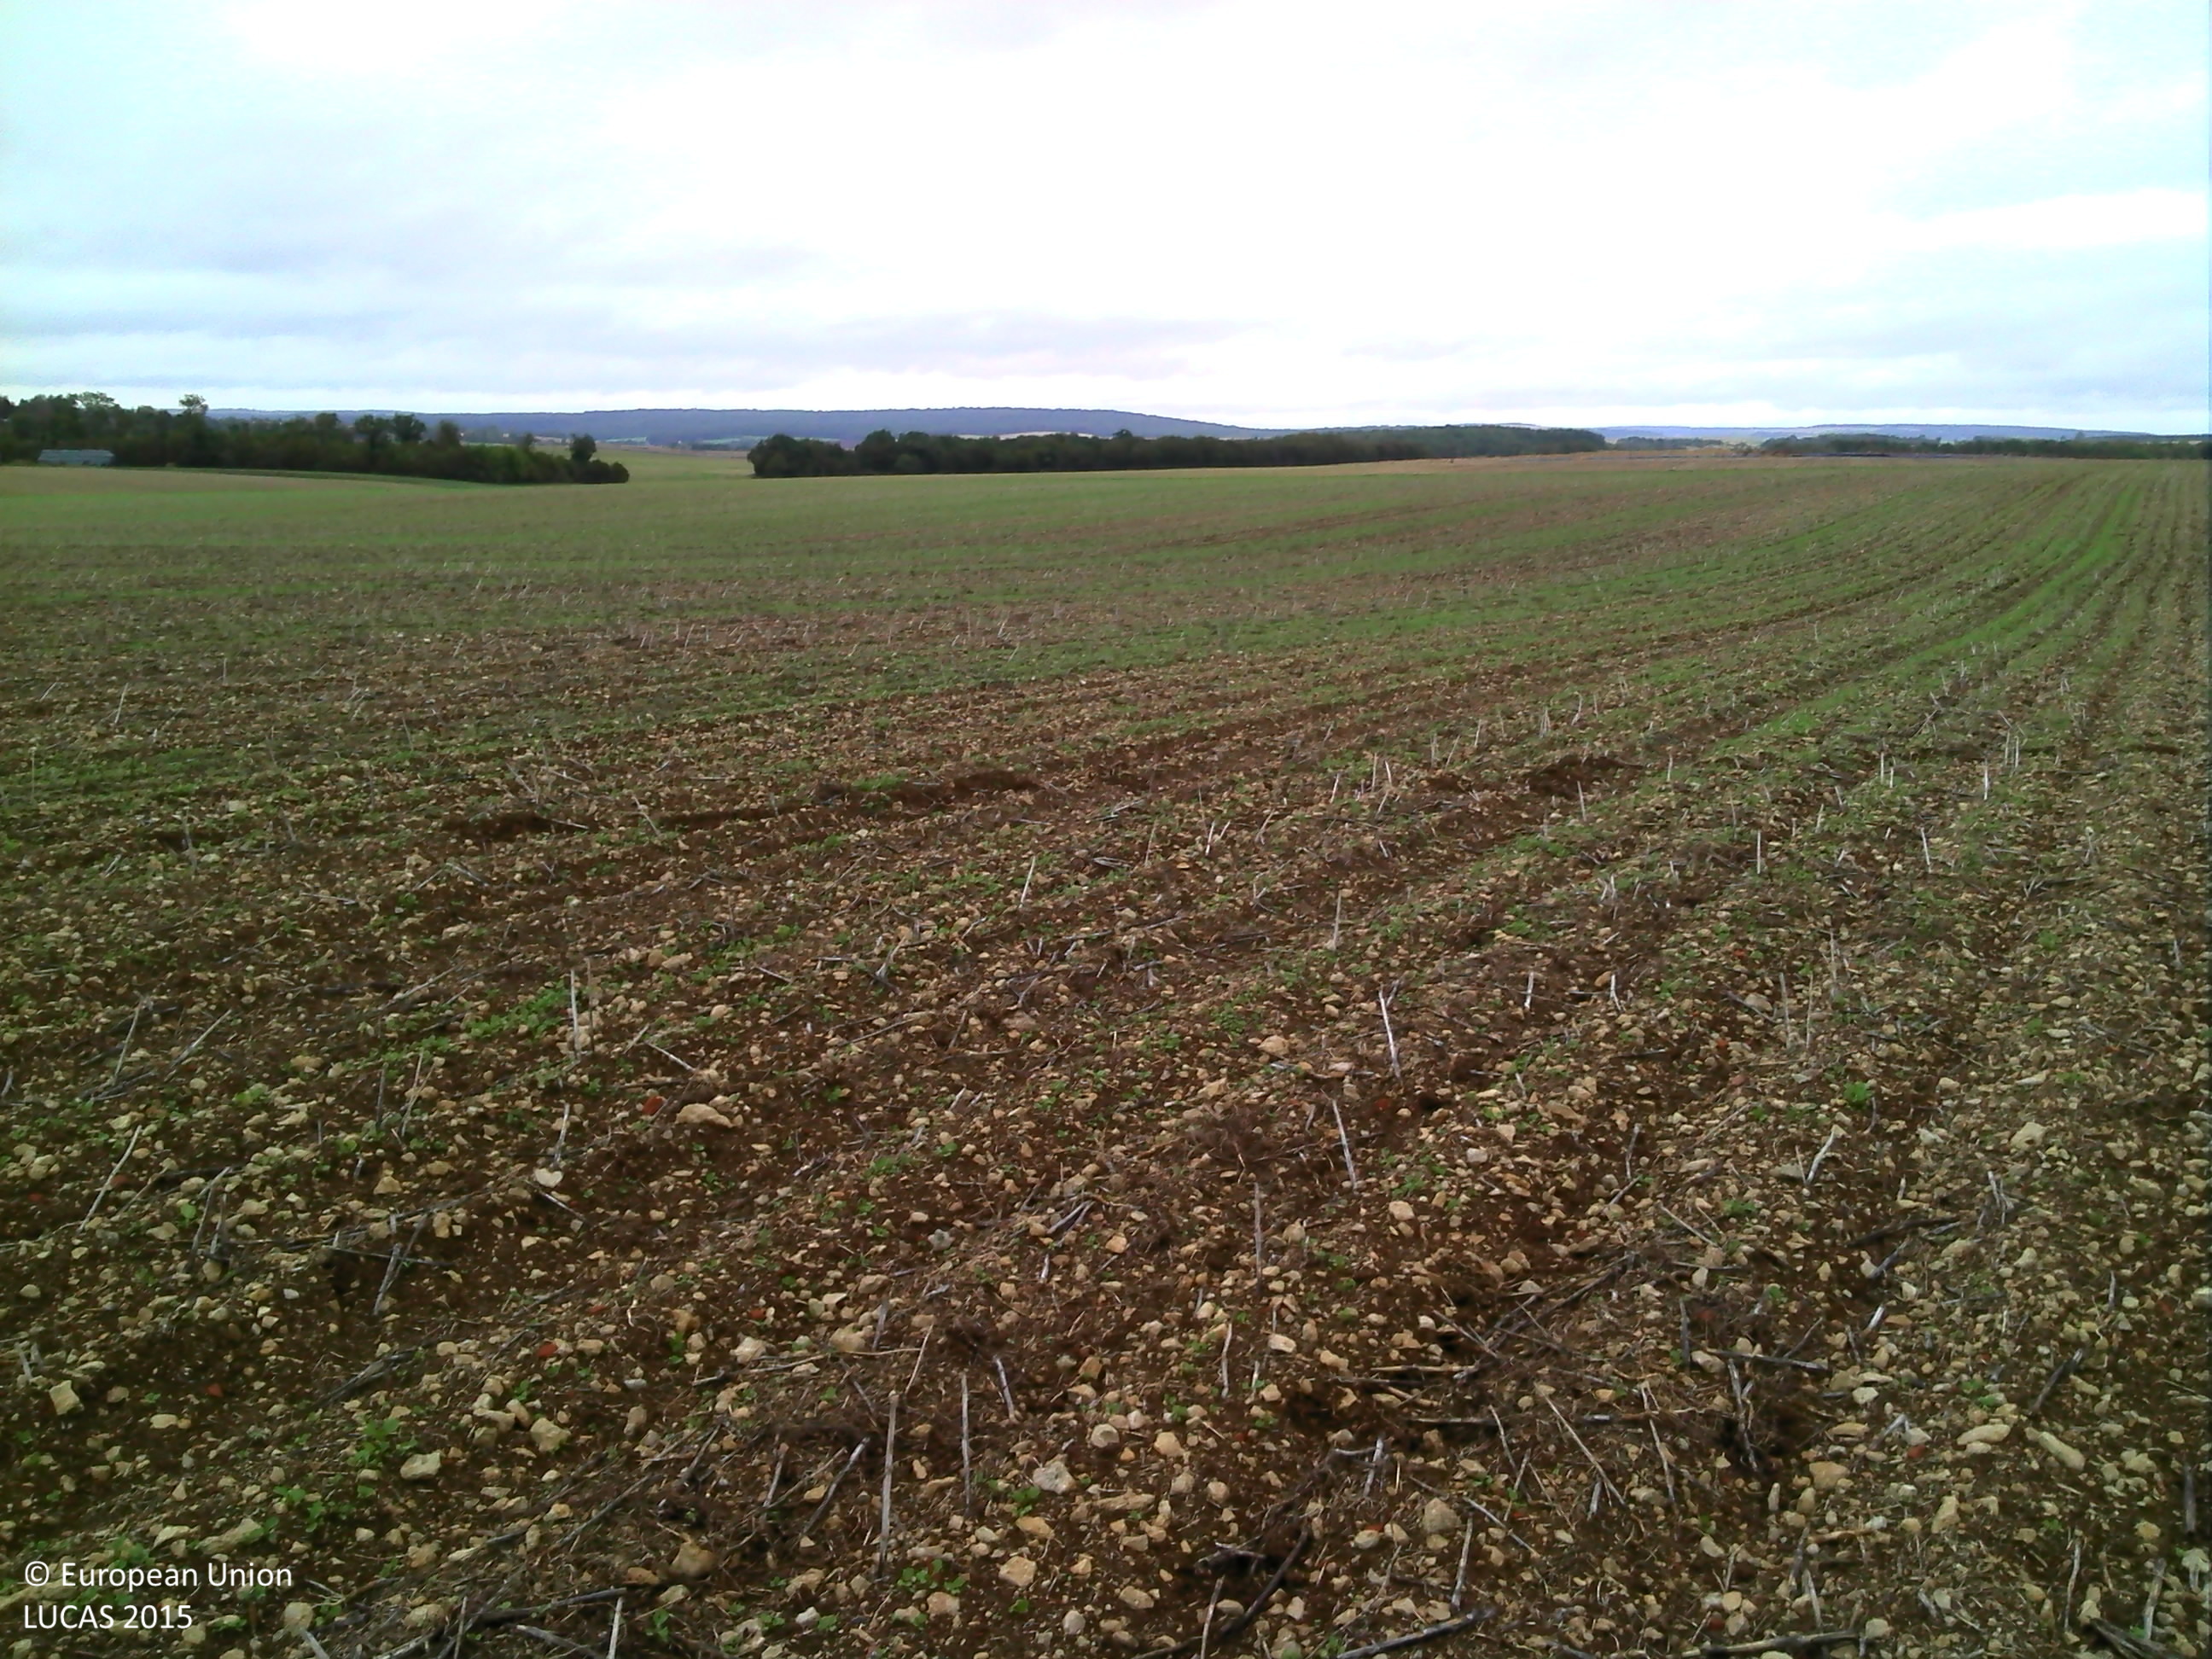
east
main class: Cropland
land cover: Rape and turnip rape
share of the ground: < 10 %
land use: Agriculture (excluding fallow land and kitchen gardens)
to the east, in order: Rape and turnip rape; Common wheat
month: September
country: FR
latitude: 48.0740
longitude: 4.6161
